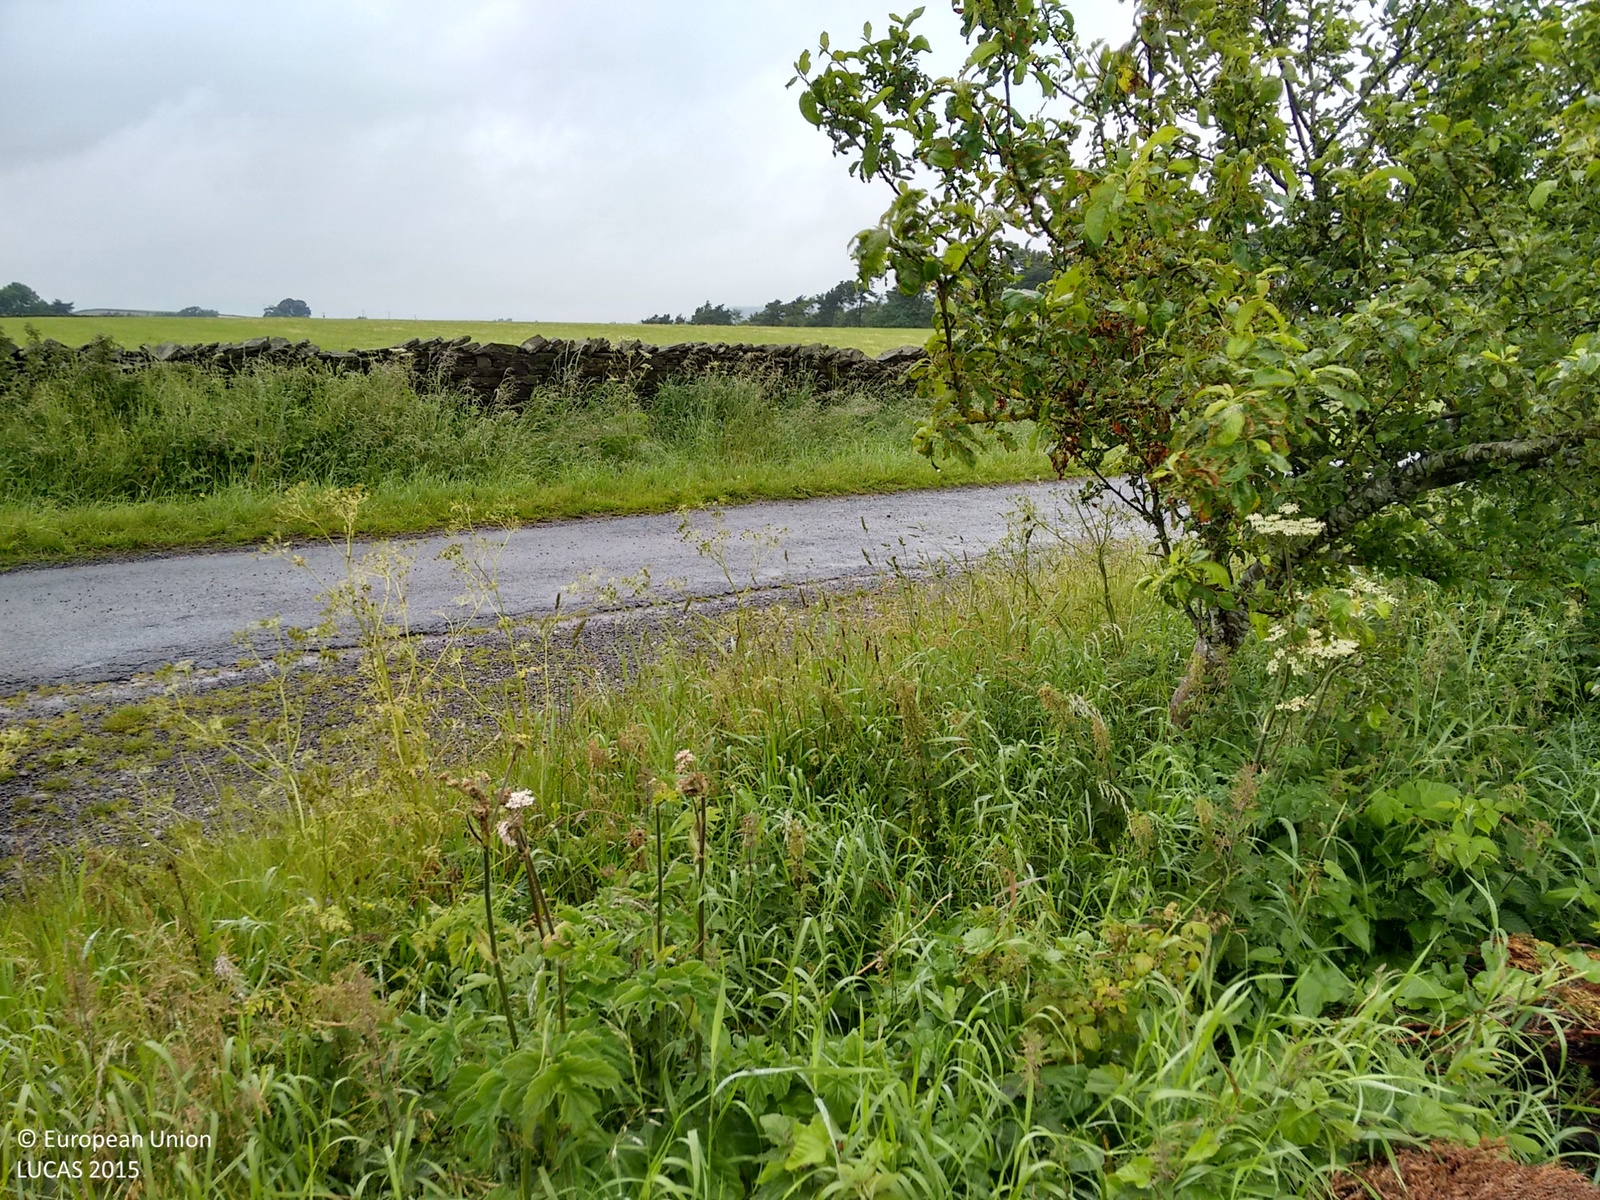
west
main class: Grassland
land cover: Grassland without tree/shrub cover
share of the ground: > 75 %
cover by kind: herbaceous plants 100 %
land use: Agriculture (excluding fallow land and kitchen gardens)
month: July
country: GB
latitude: 54.5894
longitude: -1.9553
